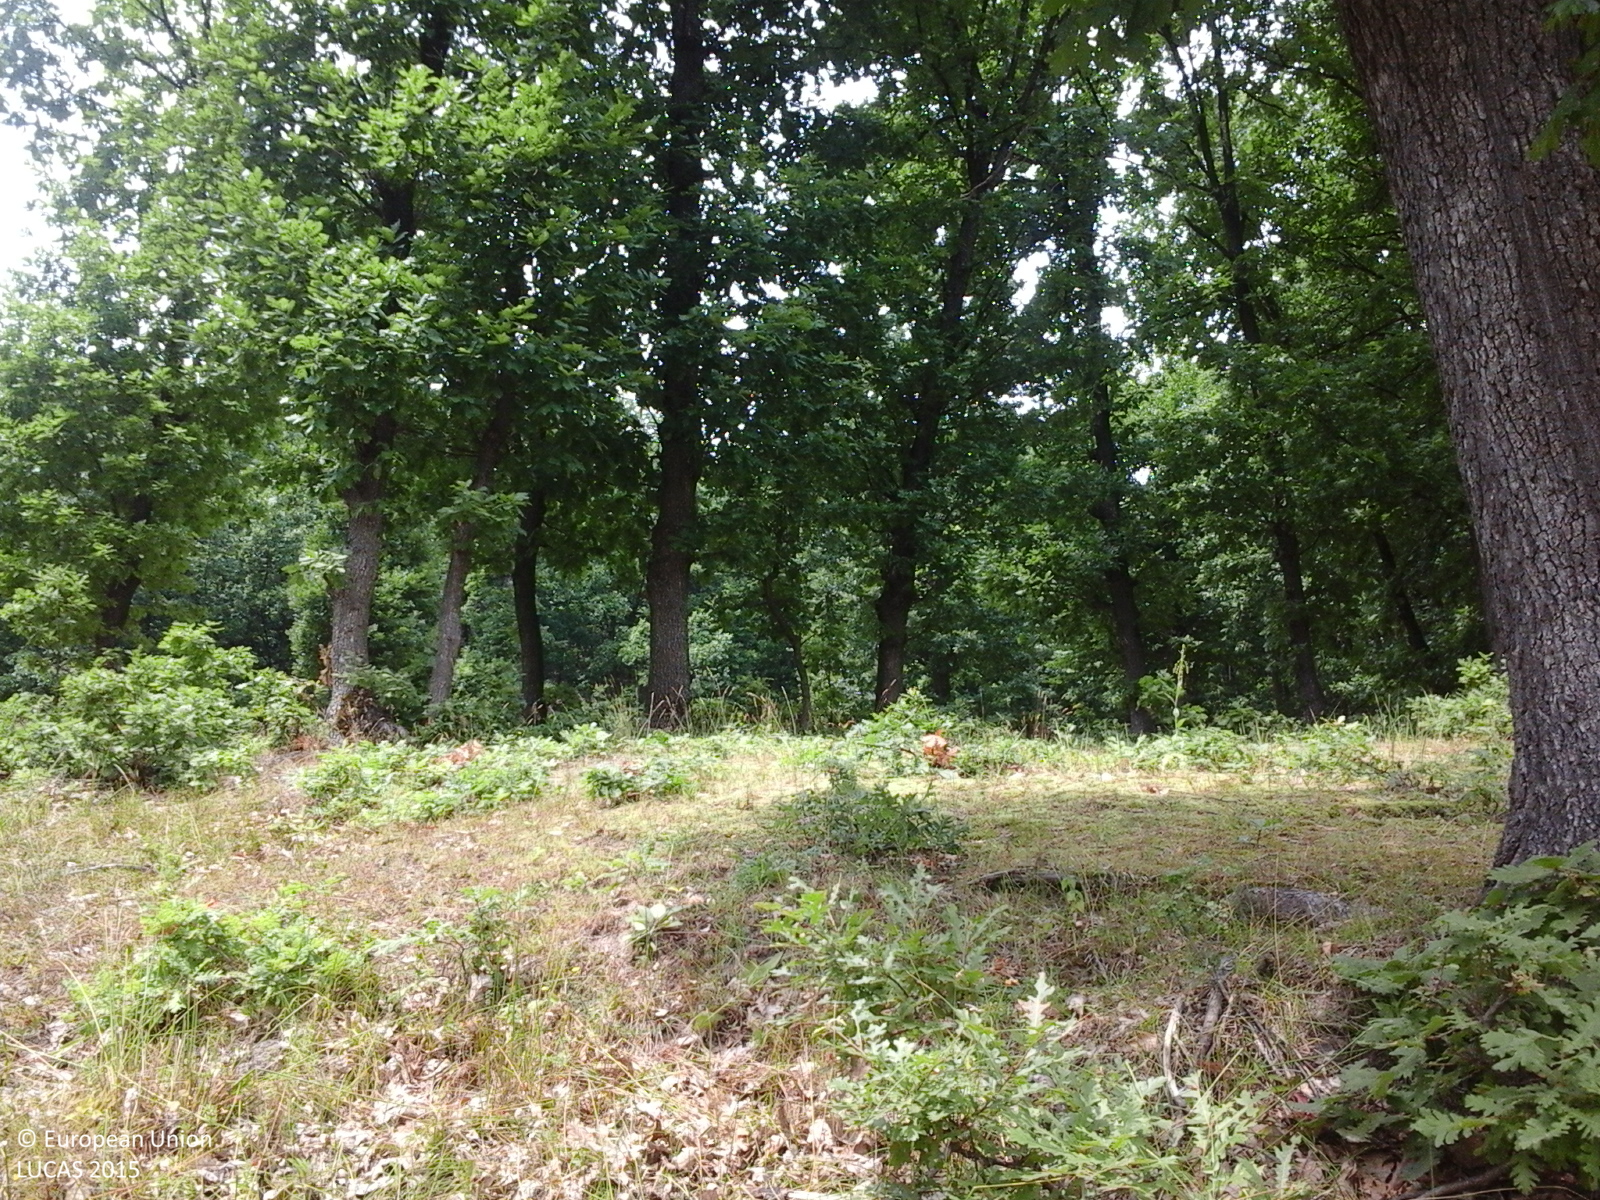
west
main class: Woodland
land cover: Broadleaved woodland
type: acidophilous oak and oak-birch forest
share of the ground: > 75 %
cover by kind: broadleaved forest trees 90 %, herbaceous plants 10 %
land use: Forestry
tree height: > 5 m
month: July
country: RO
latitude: 44.8395
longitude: 24.4053
